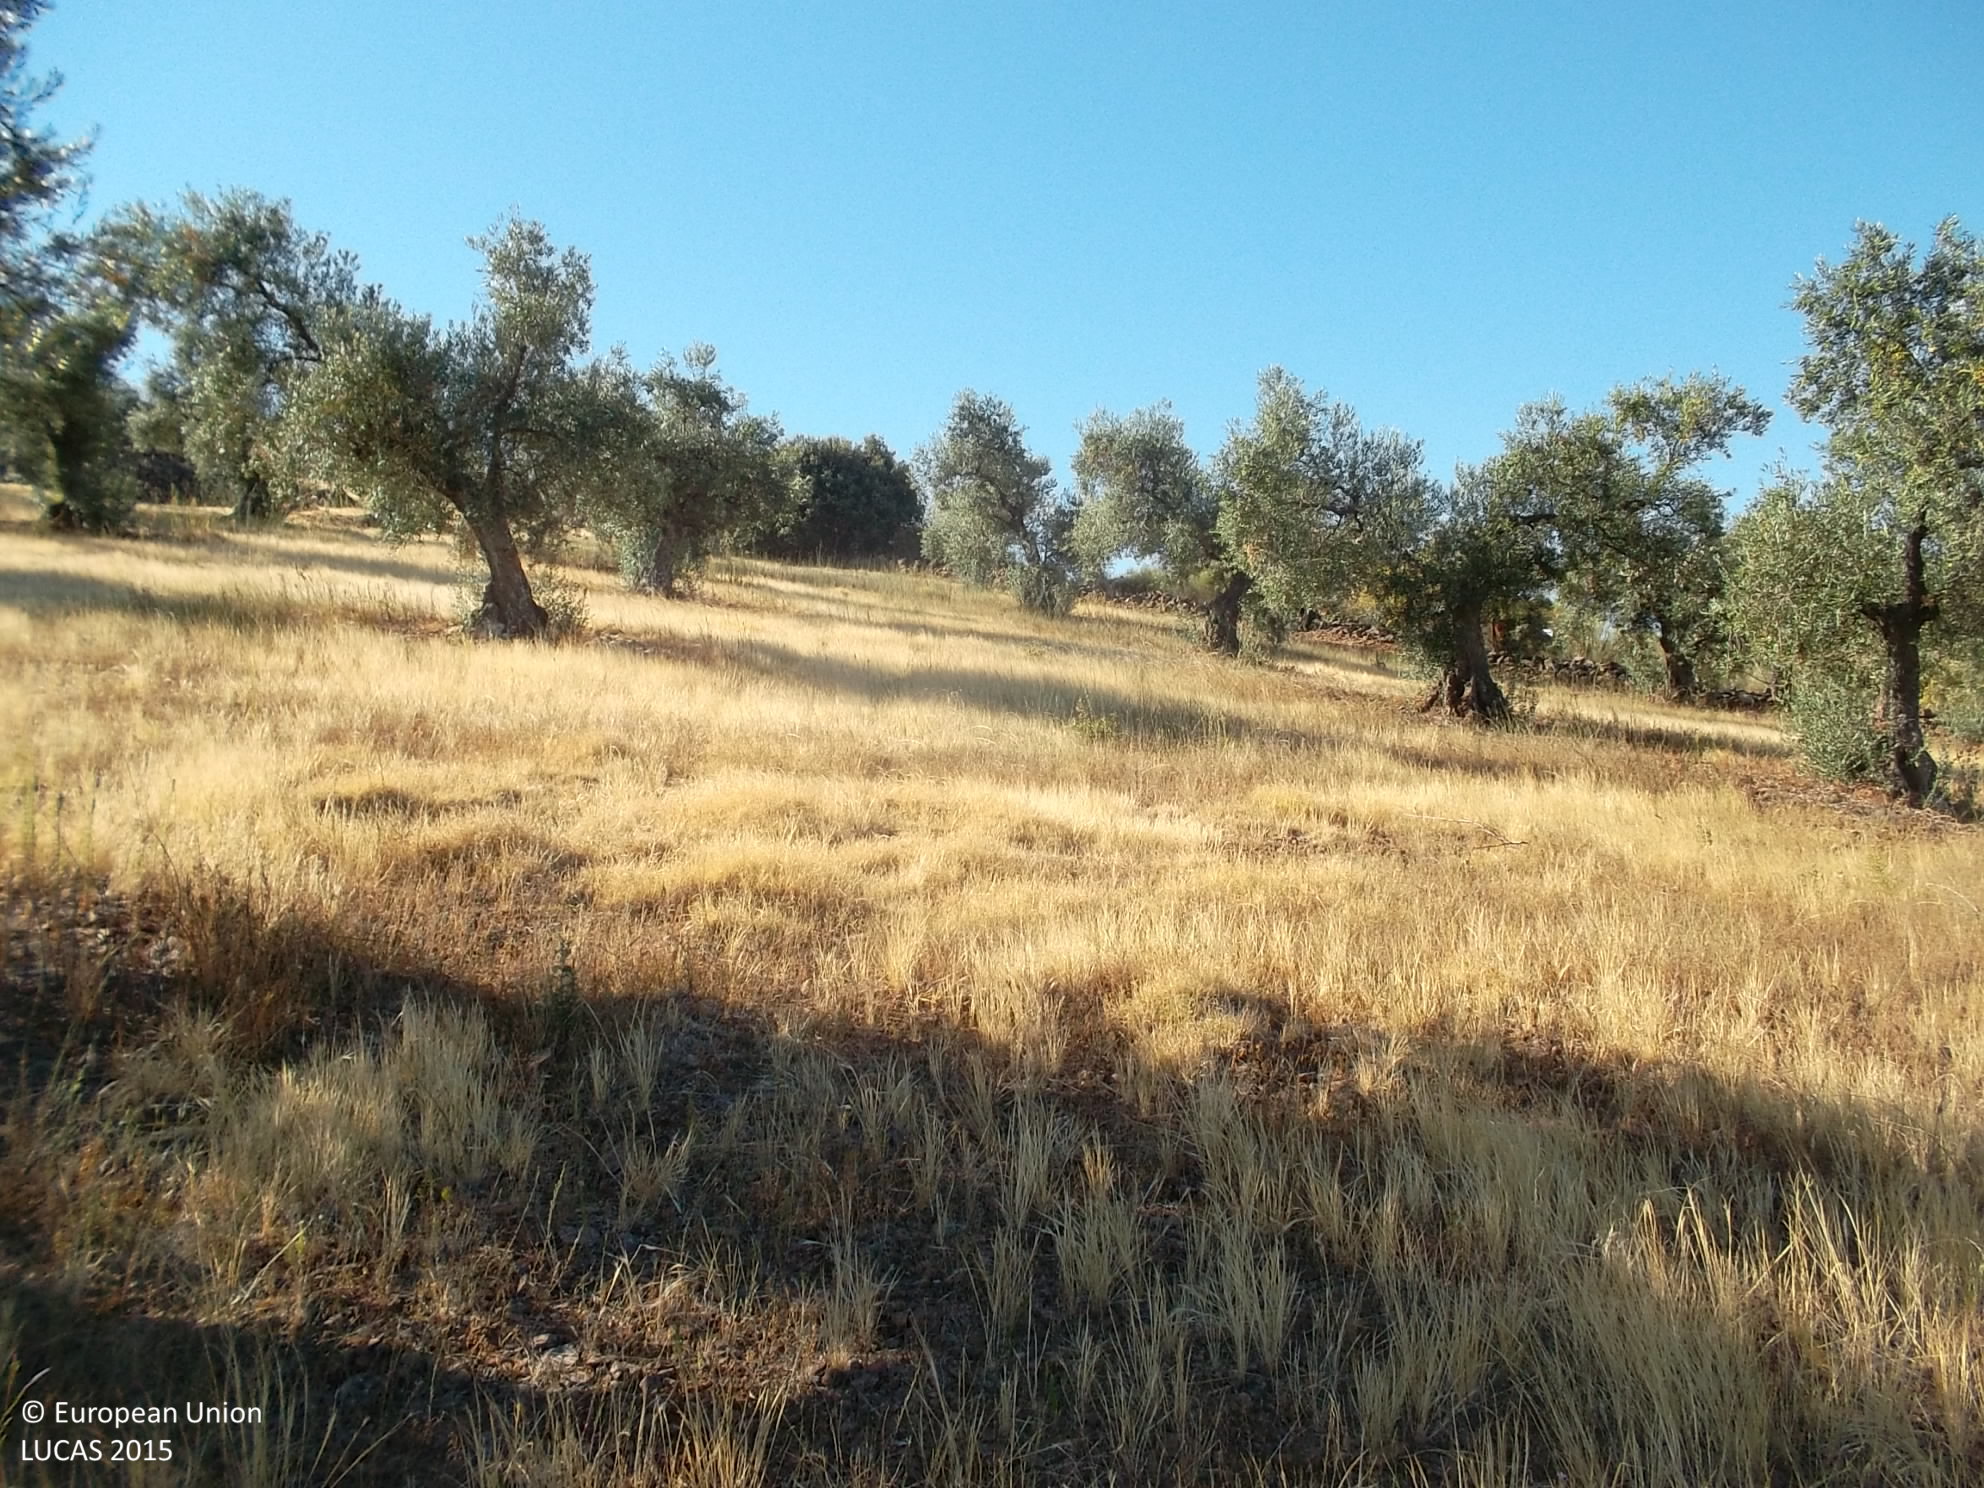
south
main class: Cropland
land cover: Olive groves
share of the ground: 25 - 50 %
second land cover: Grassland without tree/shrub cover
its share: > 75 %
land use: Agriculture (excluding fallow land and kitchen gardens)
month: August
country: ES
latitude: 38.5135
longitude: -6.5813
